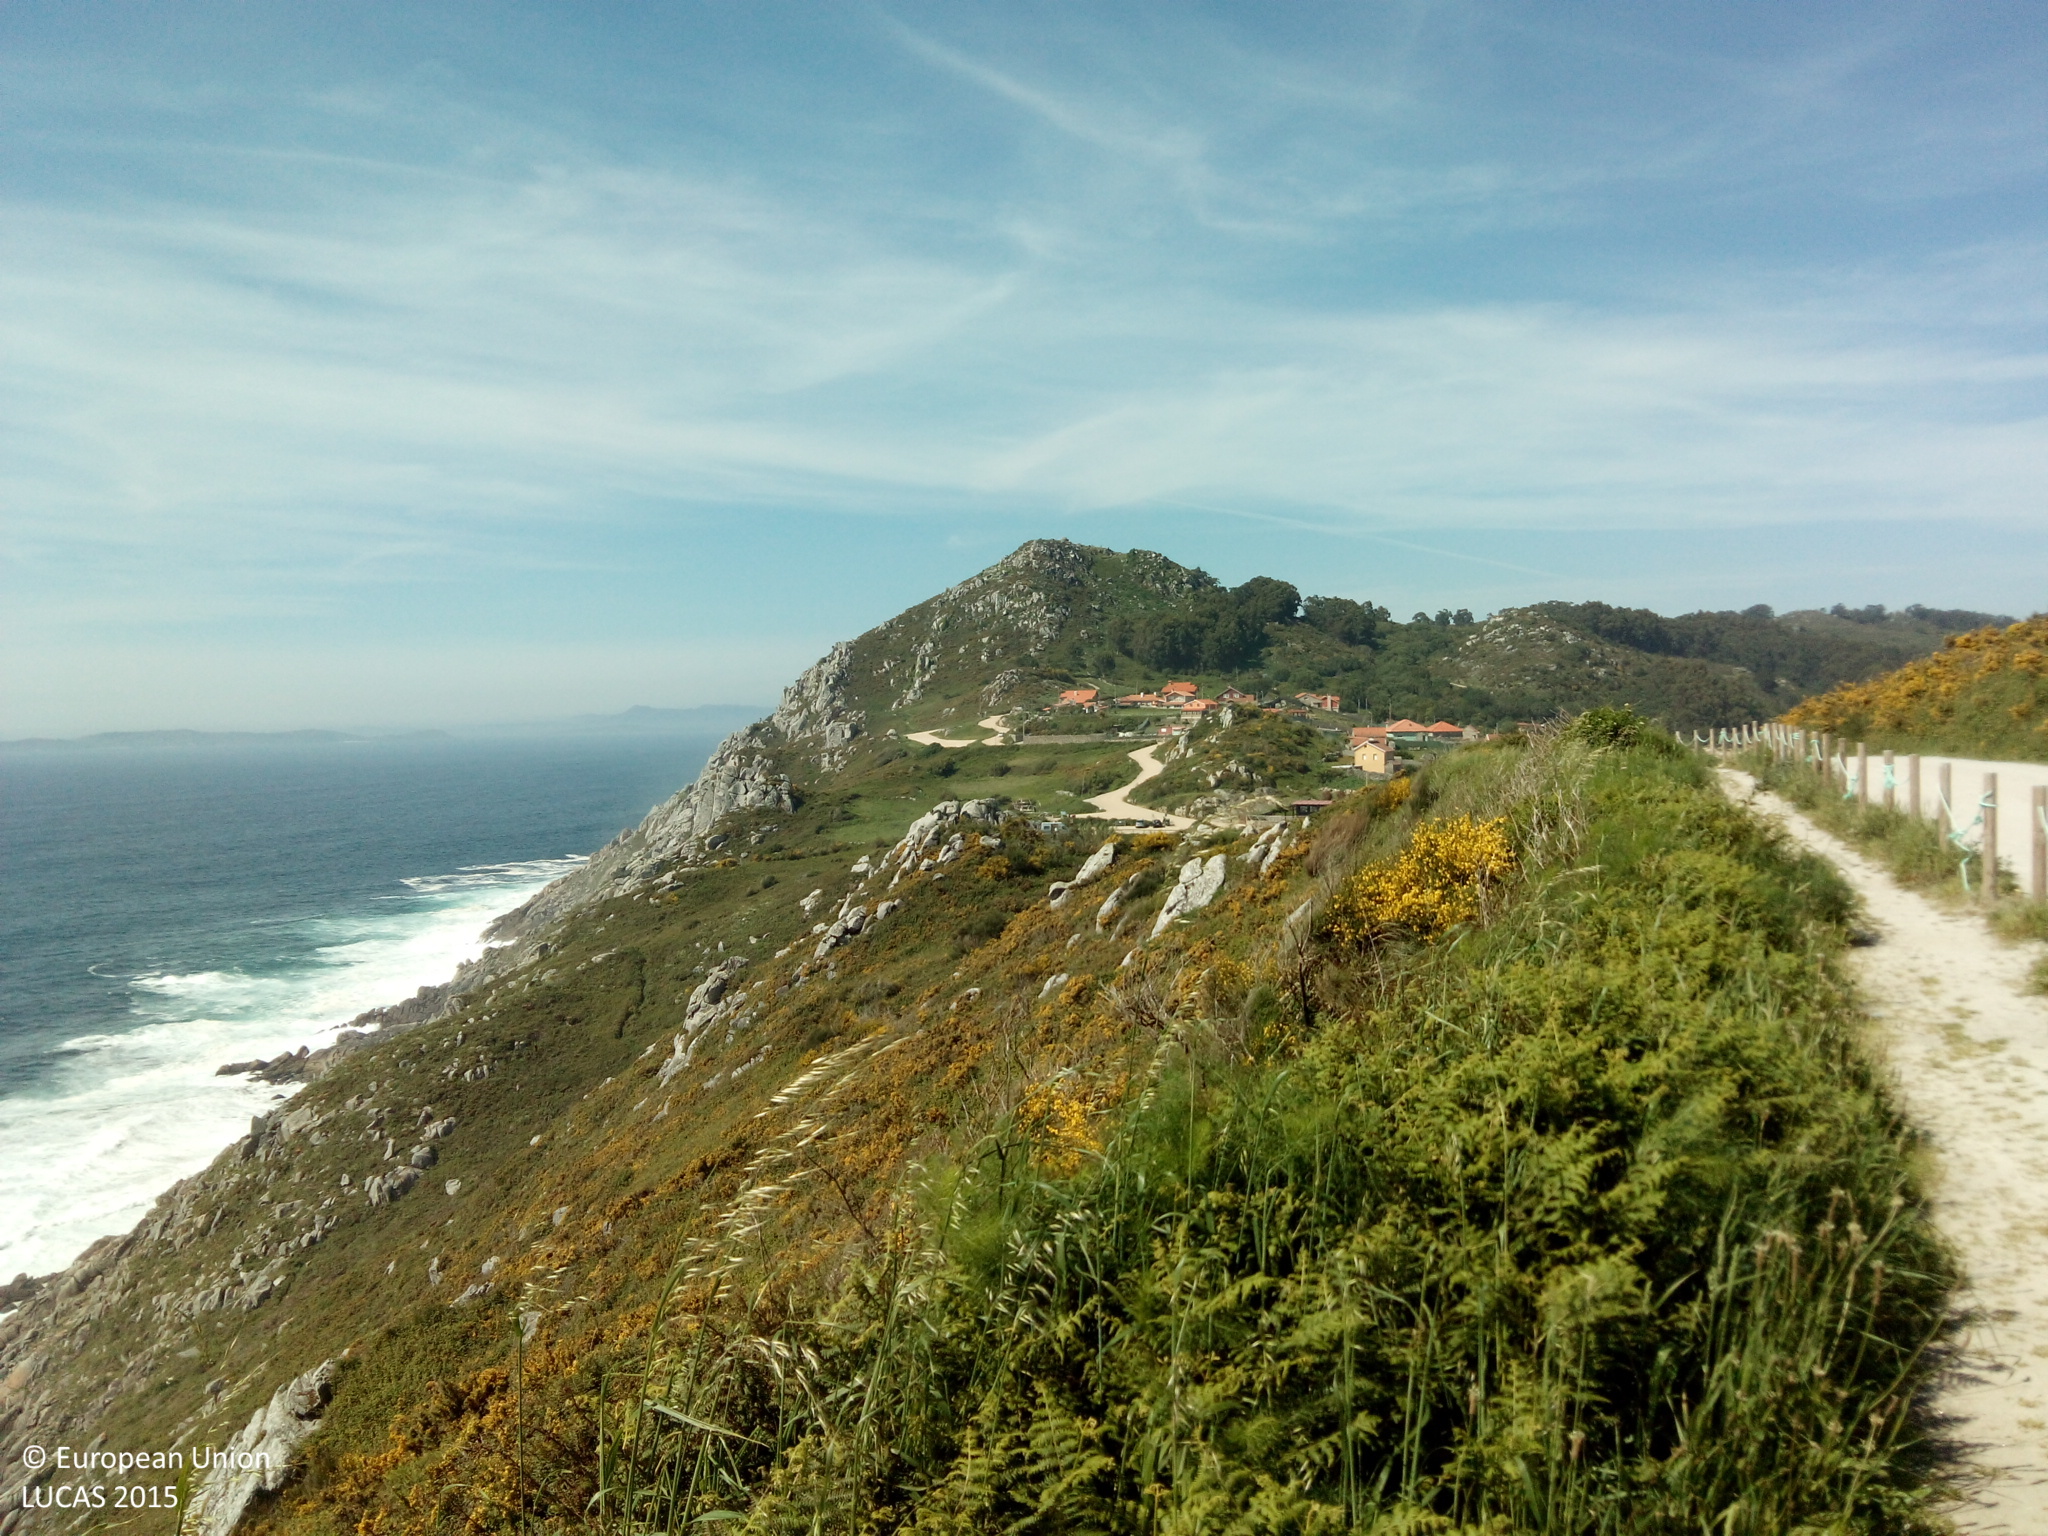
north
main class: Shrubland
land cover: Shrubland without tree cover
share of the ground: > 75 %
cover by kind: shrubs 75 %
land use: Semi-natural and natural areas not in use
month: May
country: ES
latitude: 42.2684
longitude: -8.8618
